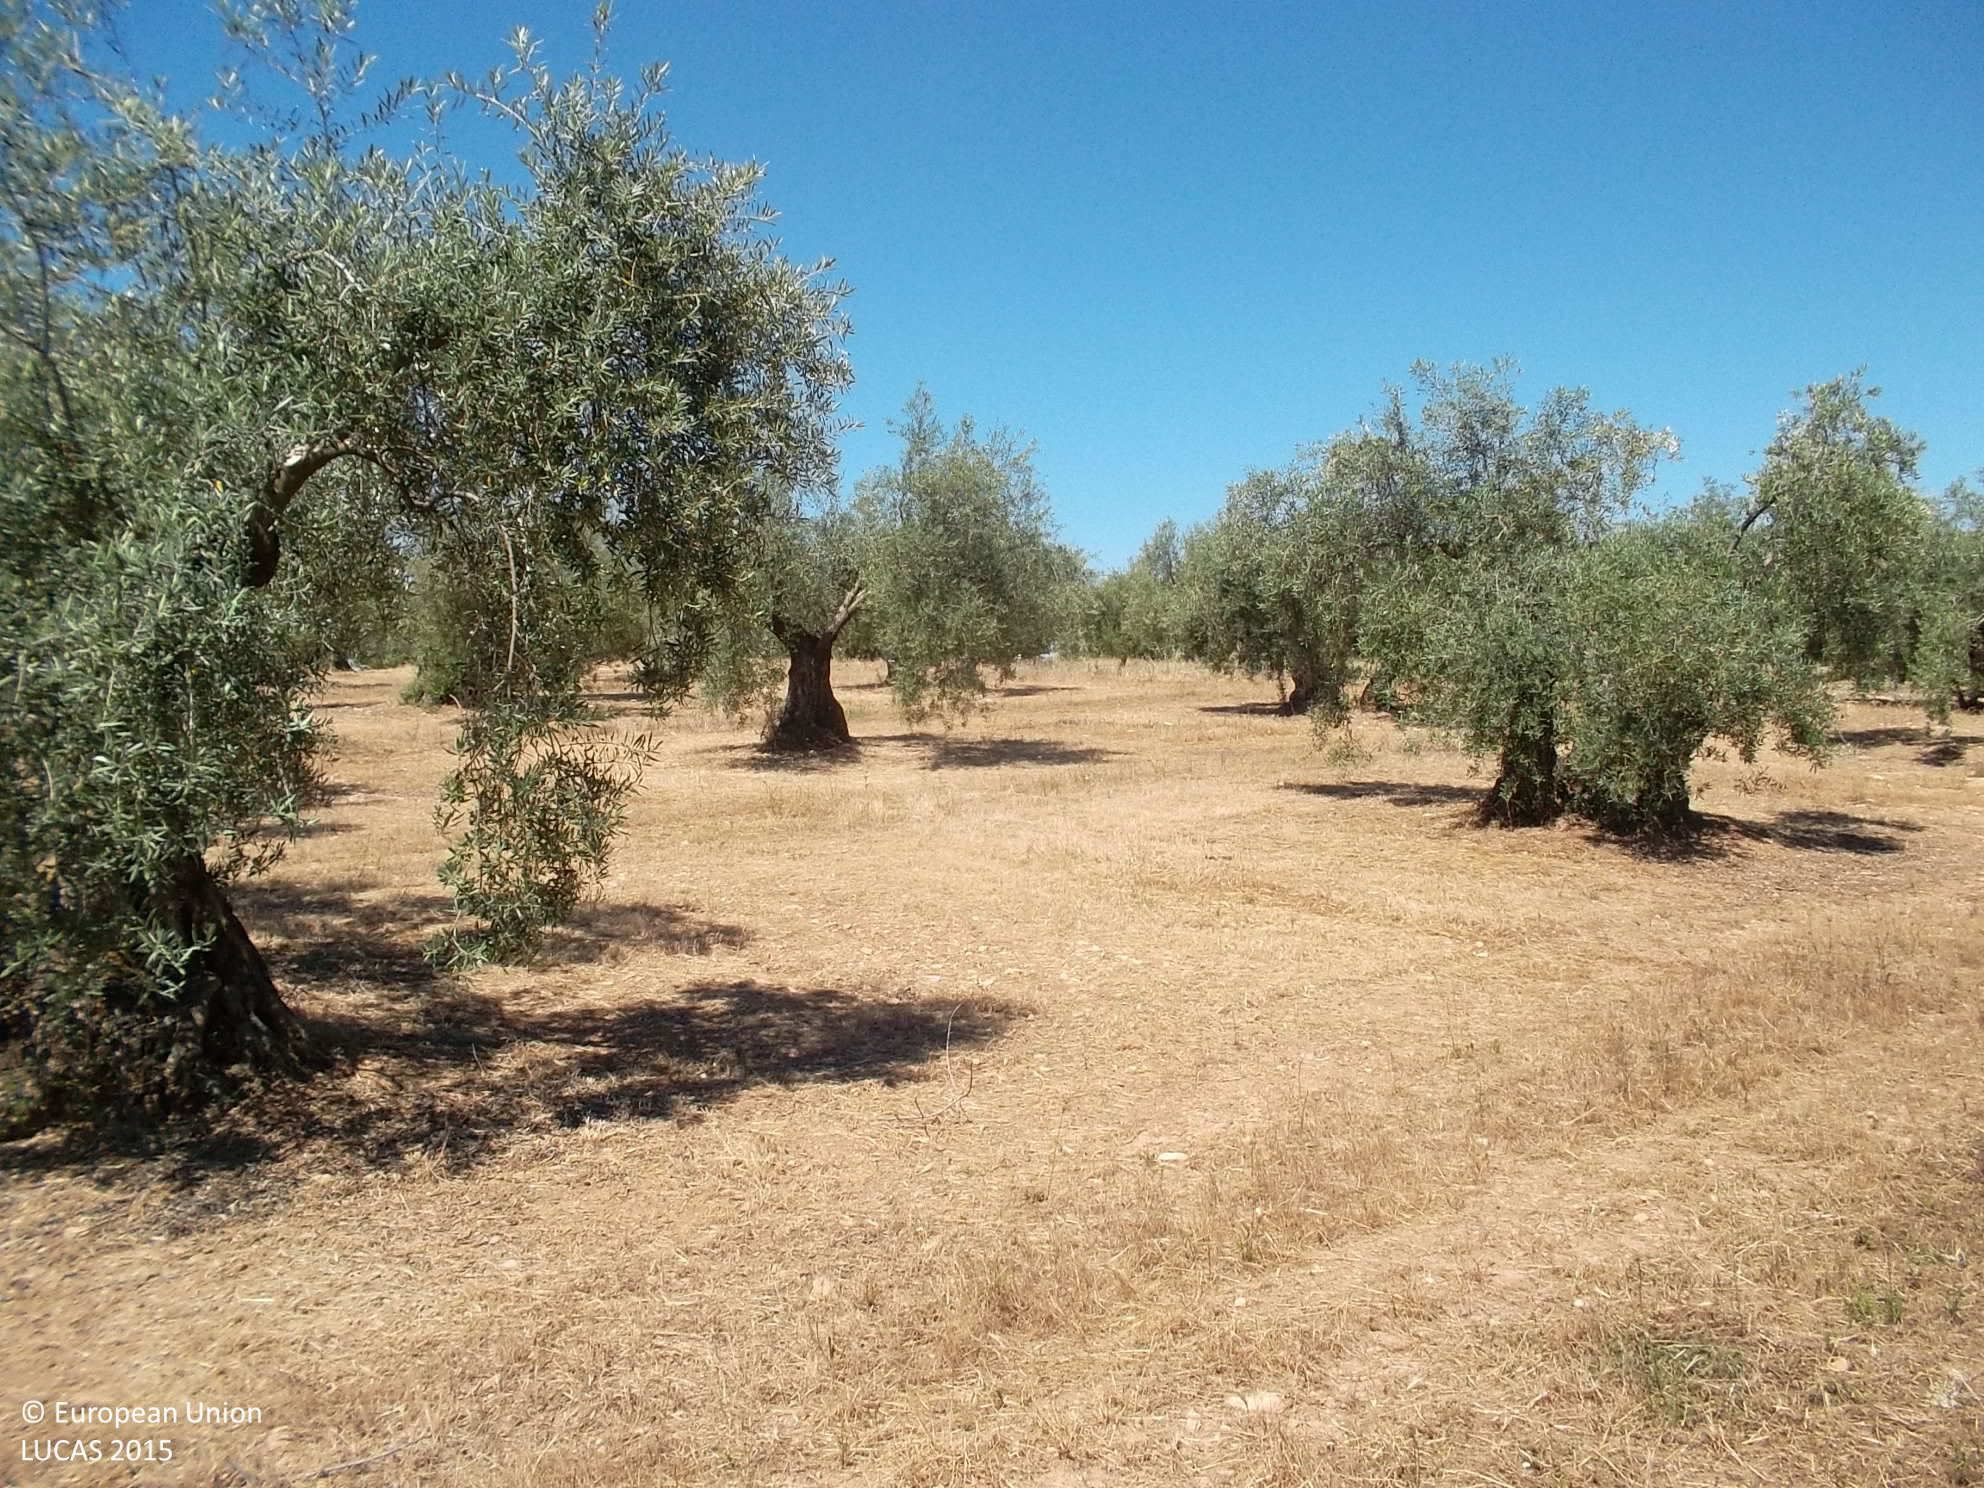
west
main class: Cropland
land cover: Olive groves
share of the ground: 25 - 50 %
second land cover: Other bare soil
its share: > 75 %
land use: Agriculture (excluding fallow land and kitchen gardens)
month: June
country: ES
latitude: 37.9059
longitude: -3.0637
